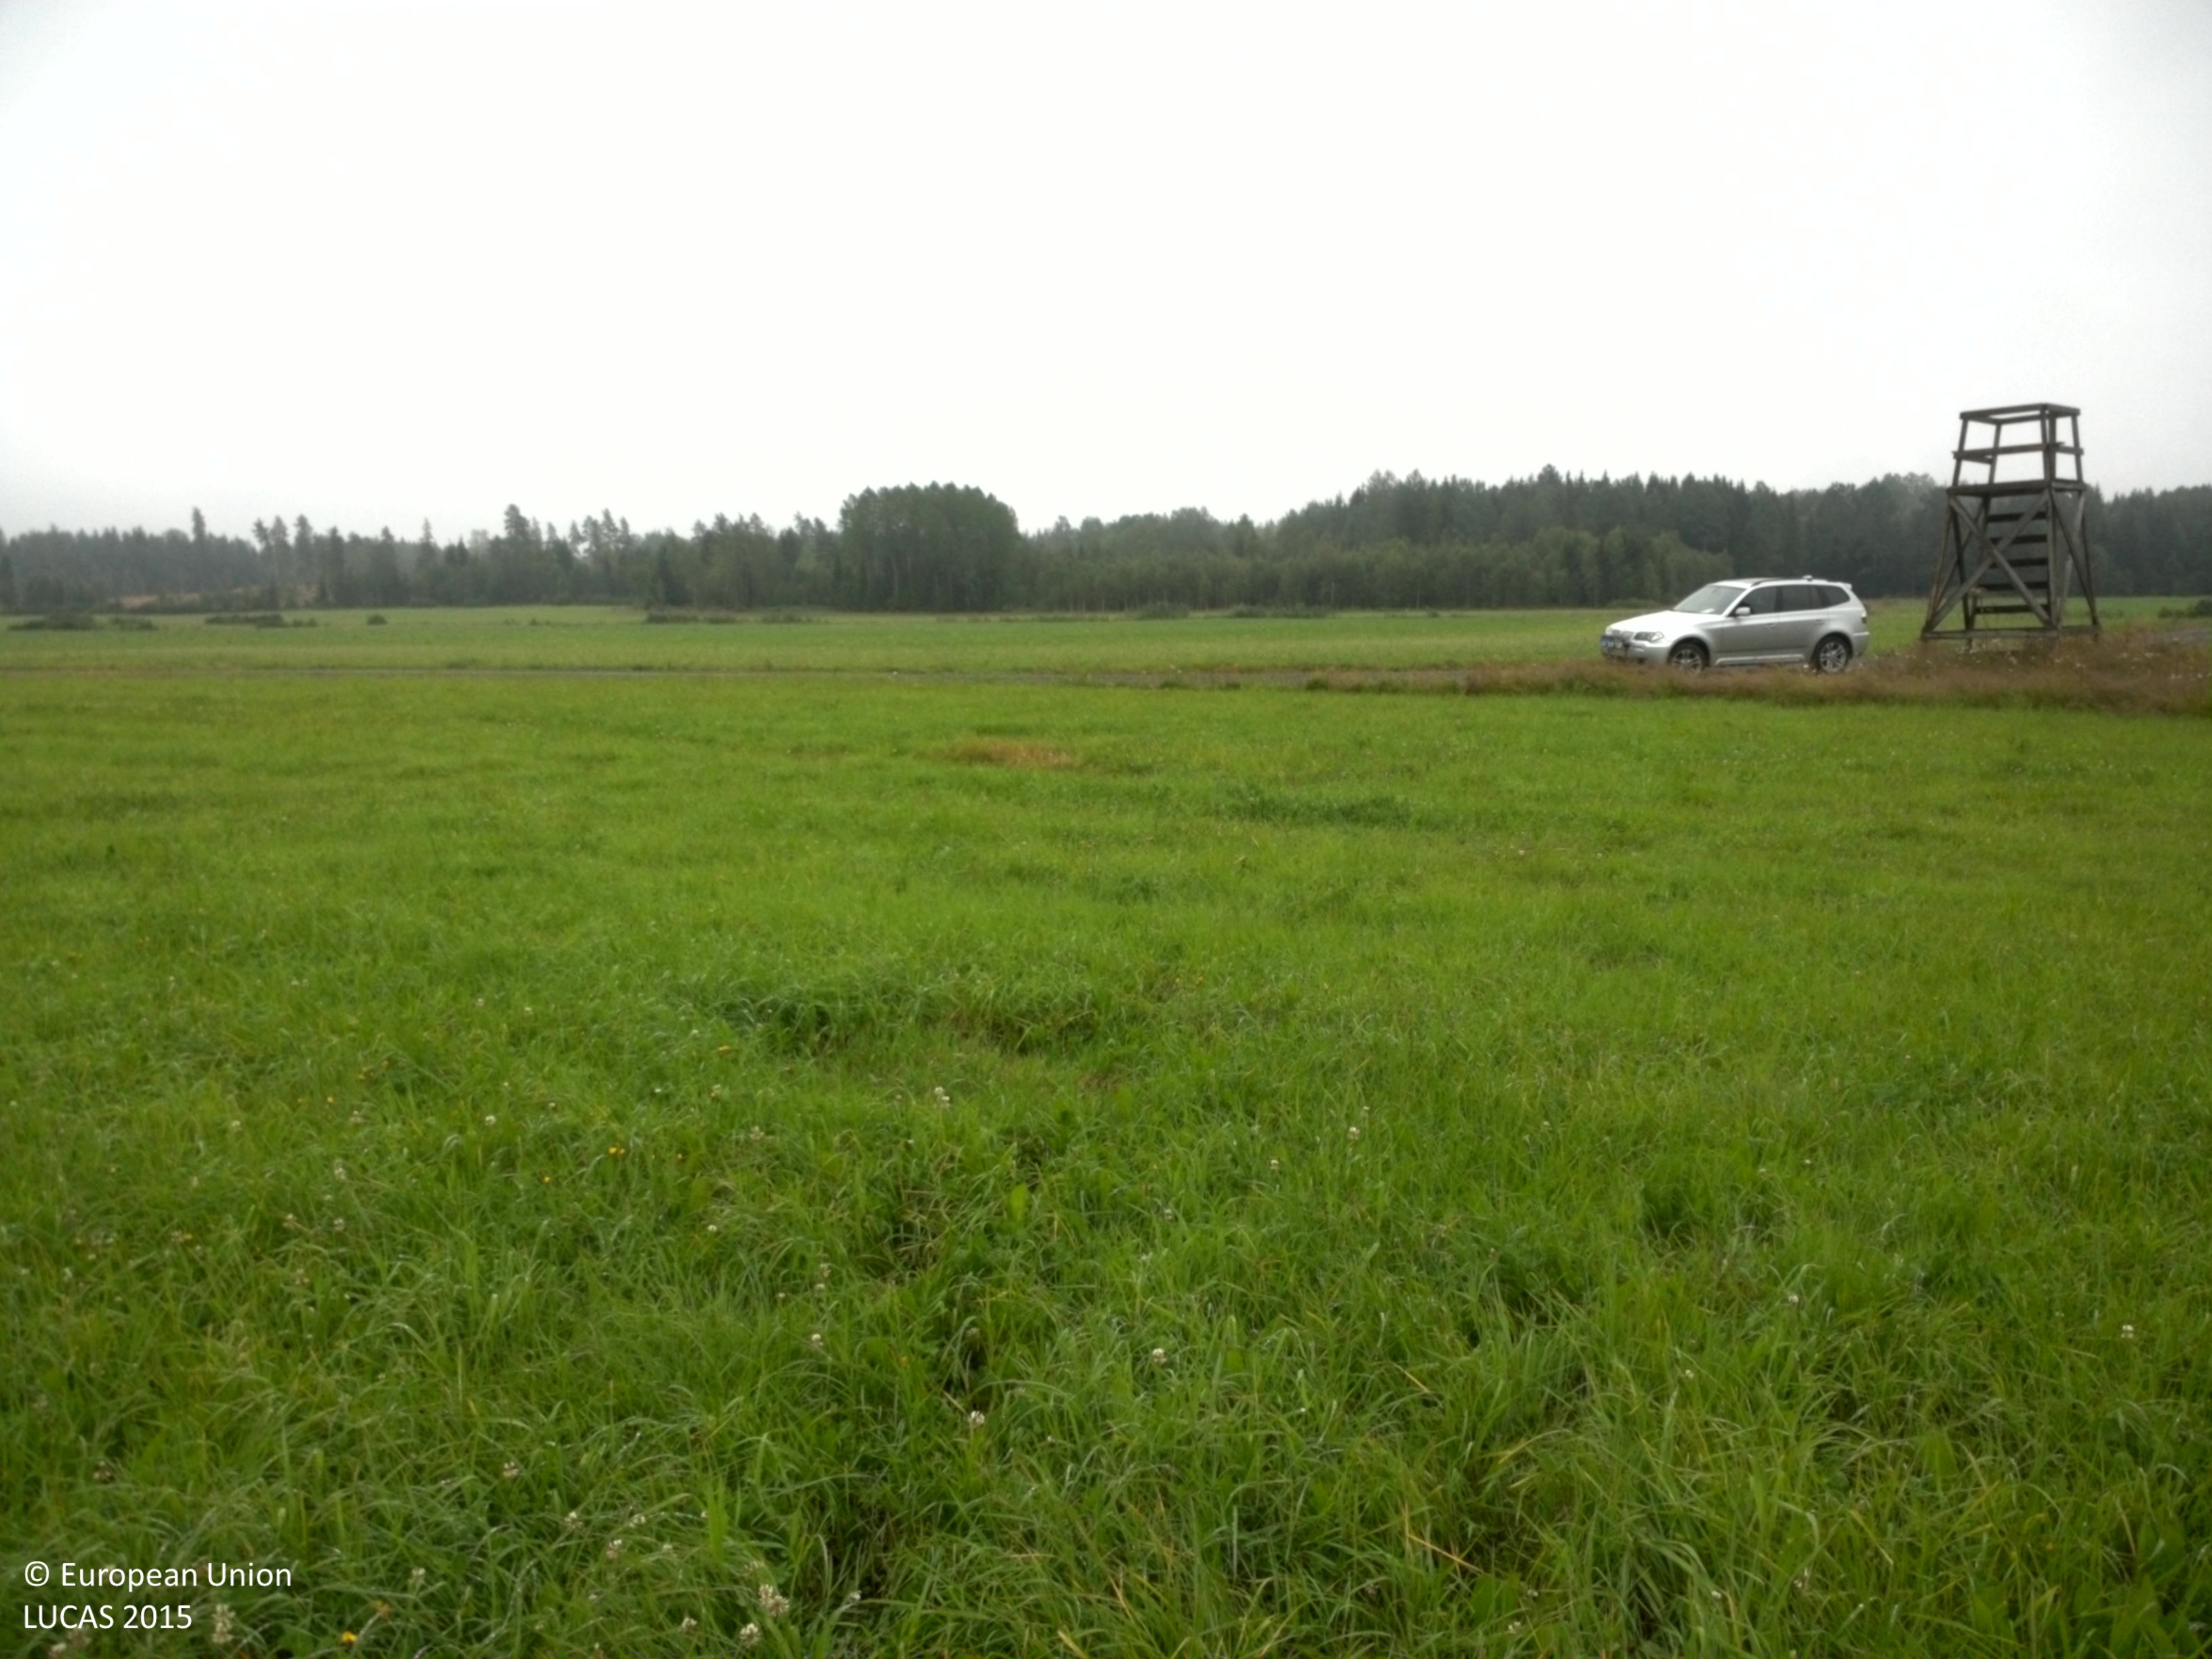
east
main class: Cropland
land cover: Temporary grasslands
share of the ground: 50 - 75 %
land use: Agriculture (excluding fallow land and kitchen gardens)
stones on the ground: < 10 %
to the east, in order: Temporary grasslands; Grass margins; Ditches and canals; Grass margins; Paved roads, cycling and walking lanes; Grass margins; Ditches and canals; Other leguminous and mixtures for fodder; Grass margins; Ditches and canals; Grass margins; Temporary grasslands
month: August
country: SE
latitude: 59.3891
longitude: 13.1442
